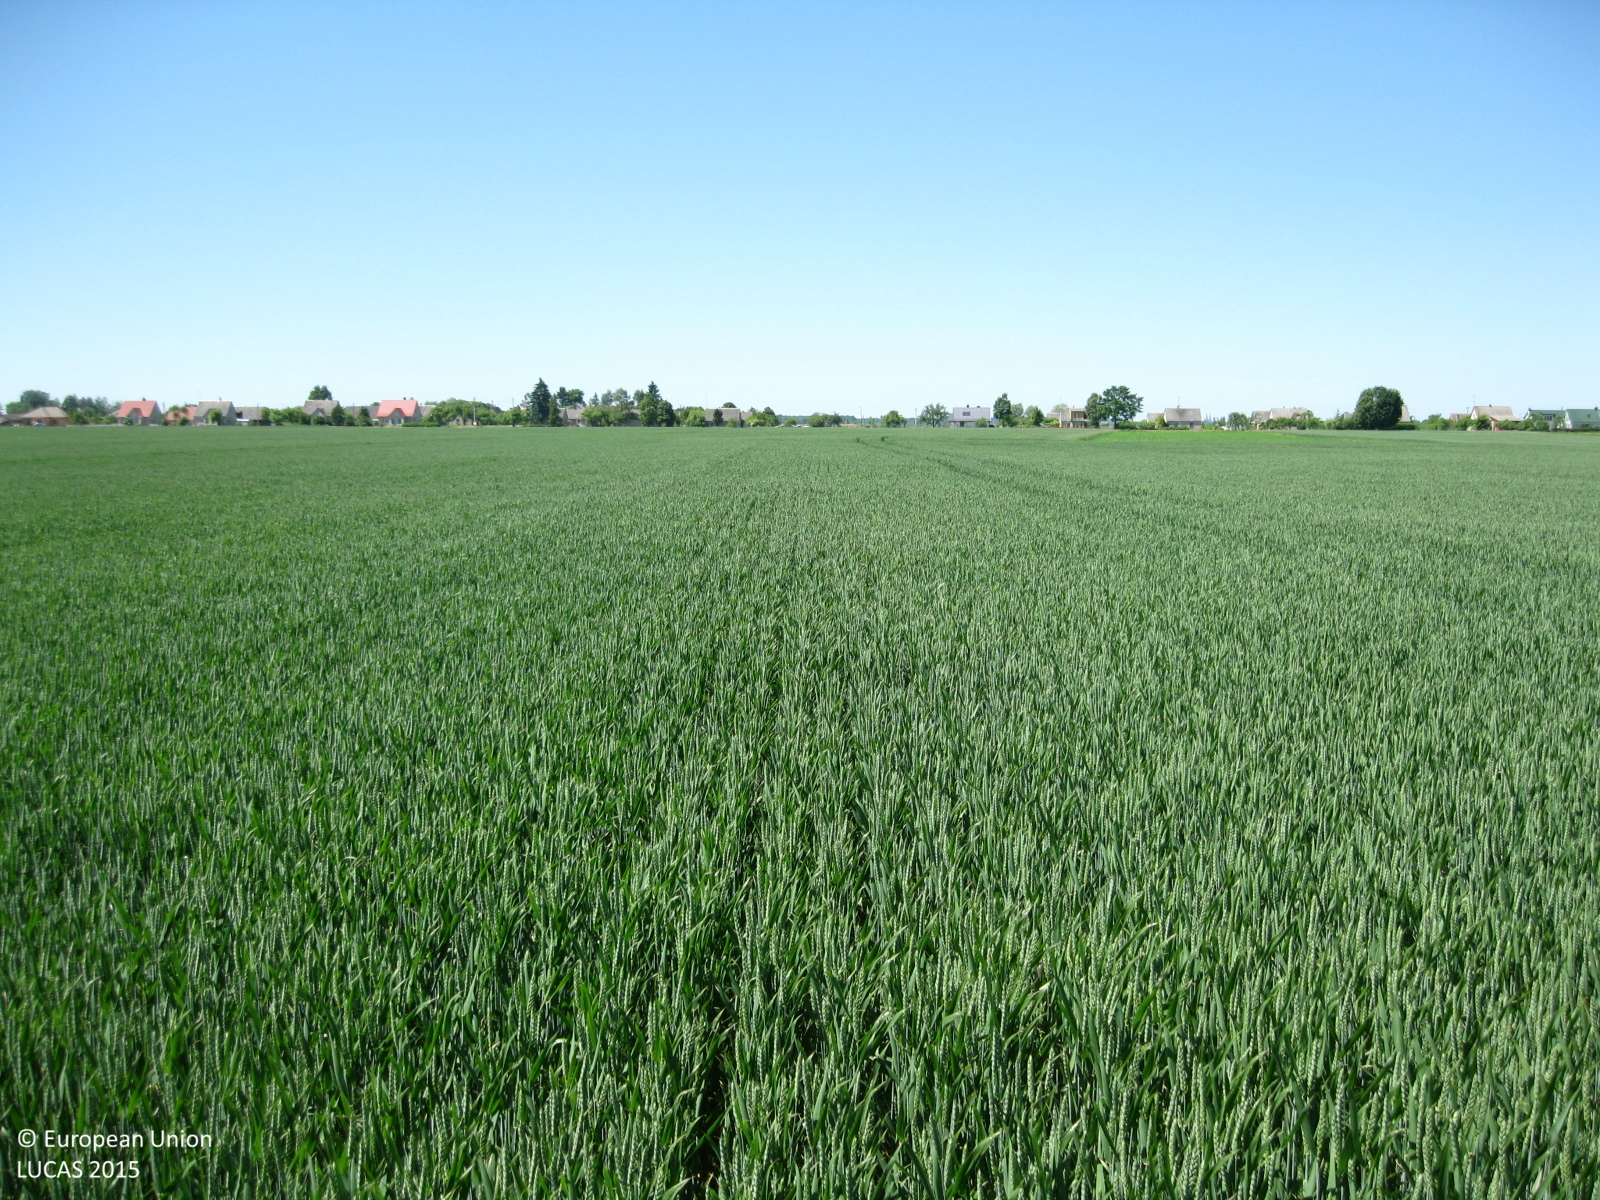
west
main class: Cropland
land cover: Common wheat
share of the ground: > 75 %
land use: Agriculture (excluding fallow land and kitchen gardens)
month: June
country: LT
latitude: 55.6779
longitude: 24.2633
